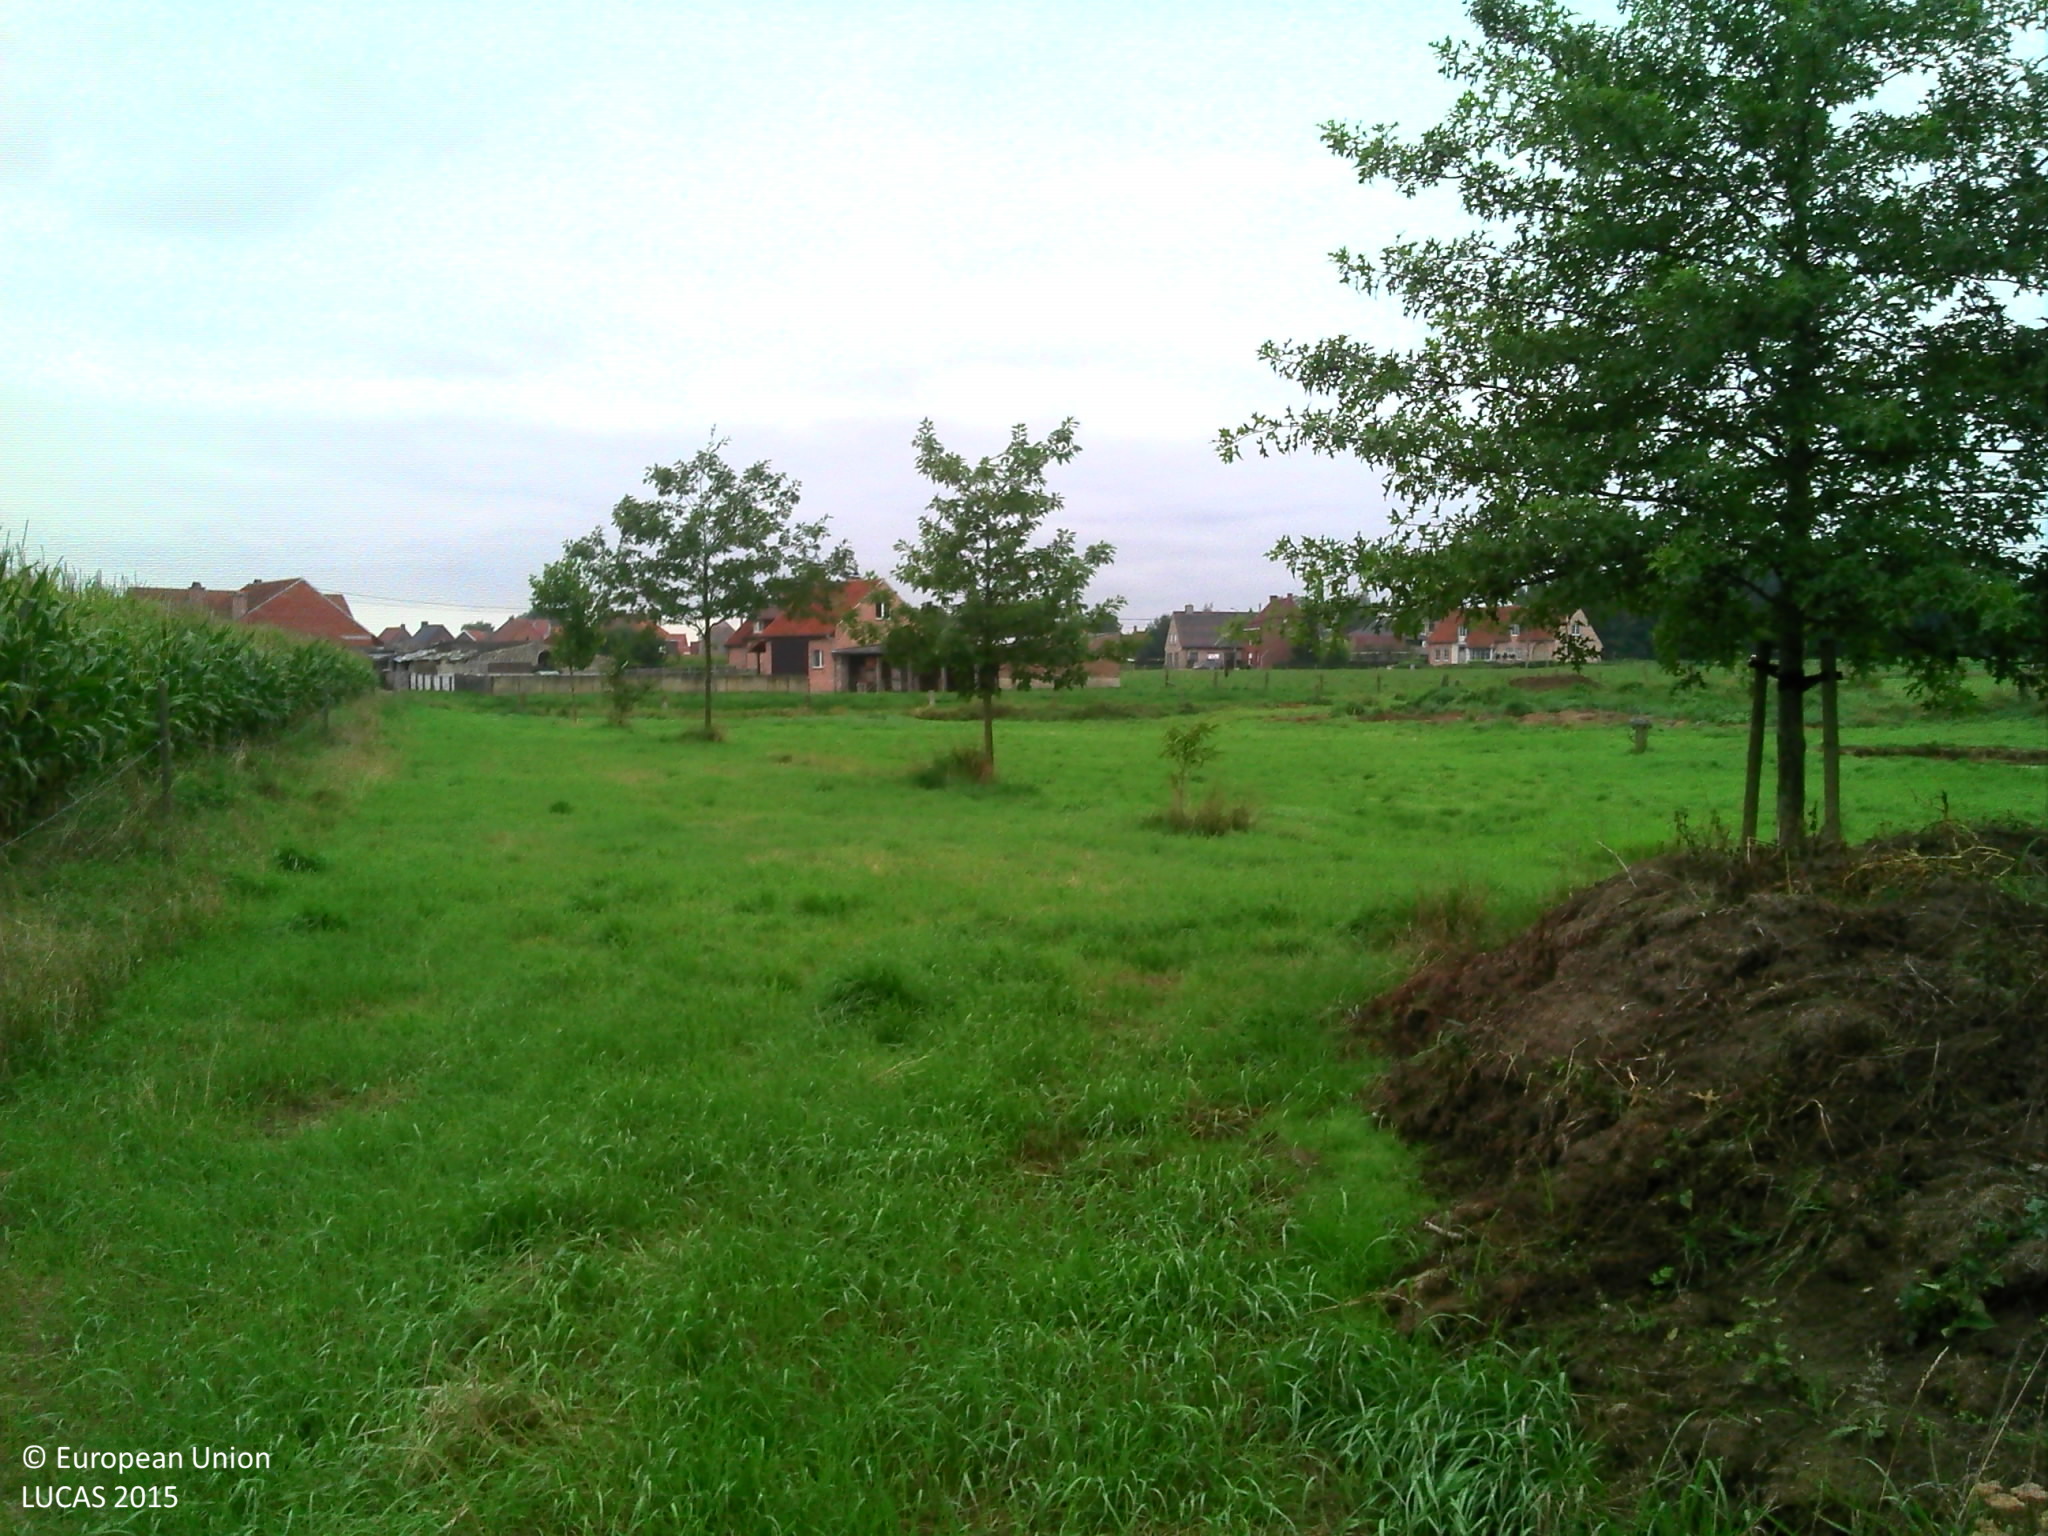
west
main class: Grassland
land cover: Grassland without tree/shrub cover
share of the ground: > 75 %
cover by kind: herbaceous plants 100 %
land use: Agriculture (excluding fallow land and kitchen gardens)
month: September
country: BE
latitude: 50.9866
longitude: 3.4246
